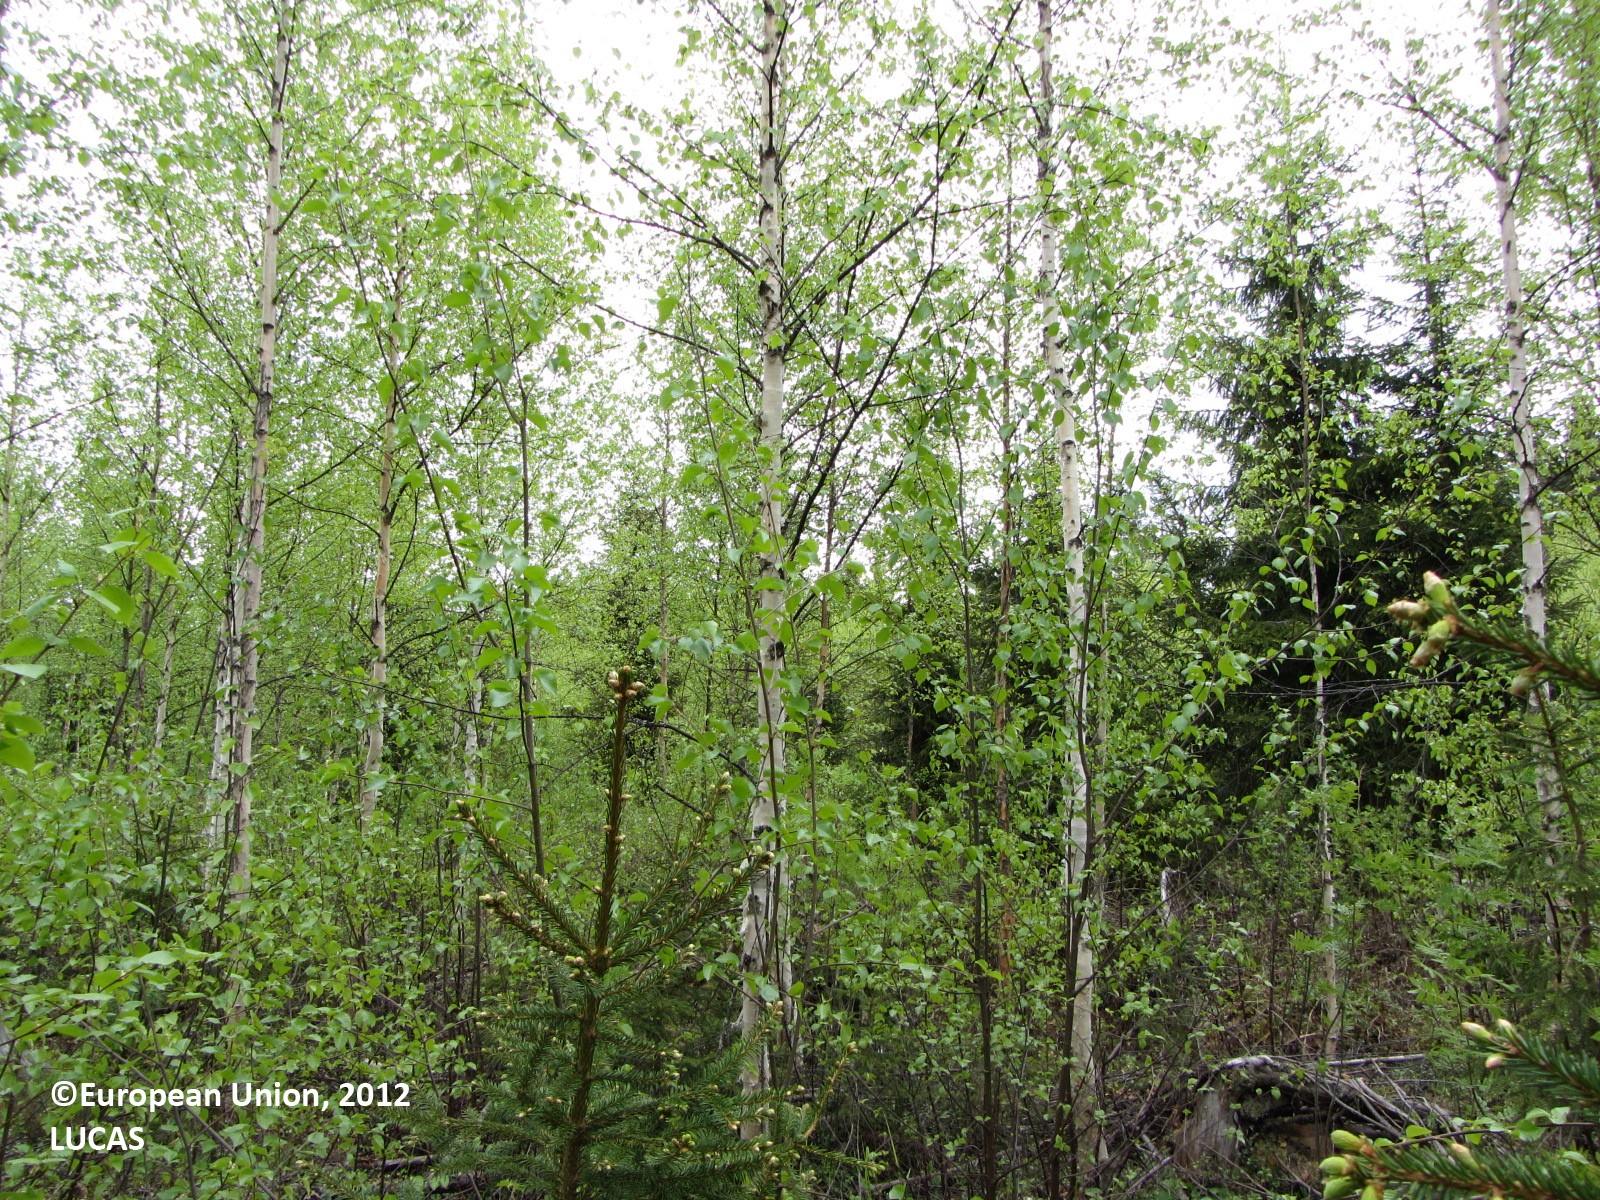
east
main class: Woodland
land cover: Broadleaved woodland
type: hemiboreal forest and nemoral coniferous forest and mixed broadleaved-coniferous forest
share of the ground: > 75 %
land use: Forestry
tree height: > 5 m
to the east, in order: Broadleaved woodland; Spruce dominated coniferous woodland; Spruce dominated mixed woodland; Ditches and canals; Spruce dominated mixed woodland; Ditches and canals; Broadleaved woodland; Spruce dominated mixed woodland; Broadleaved woodland; Ditches and canals; Spruce dominated mixed woodland; Ditches and canals; Spruce dominated mixed woodland; Broadleaved woodland; Spruce dominated mixed woodland; Ditches and canals; Spruce dominated mixed woodland; Ditches and canals; Spruce dominated coniferous woodland; Spruce dominated mixed woodland; Ditches and canals; Temporary grasslands
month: May
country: FI
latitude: 62.4092
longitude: 25.3403
